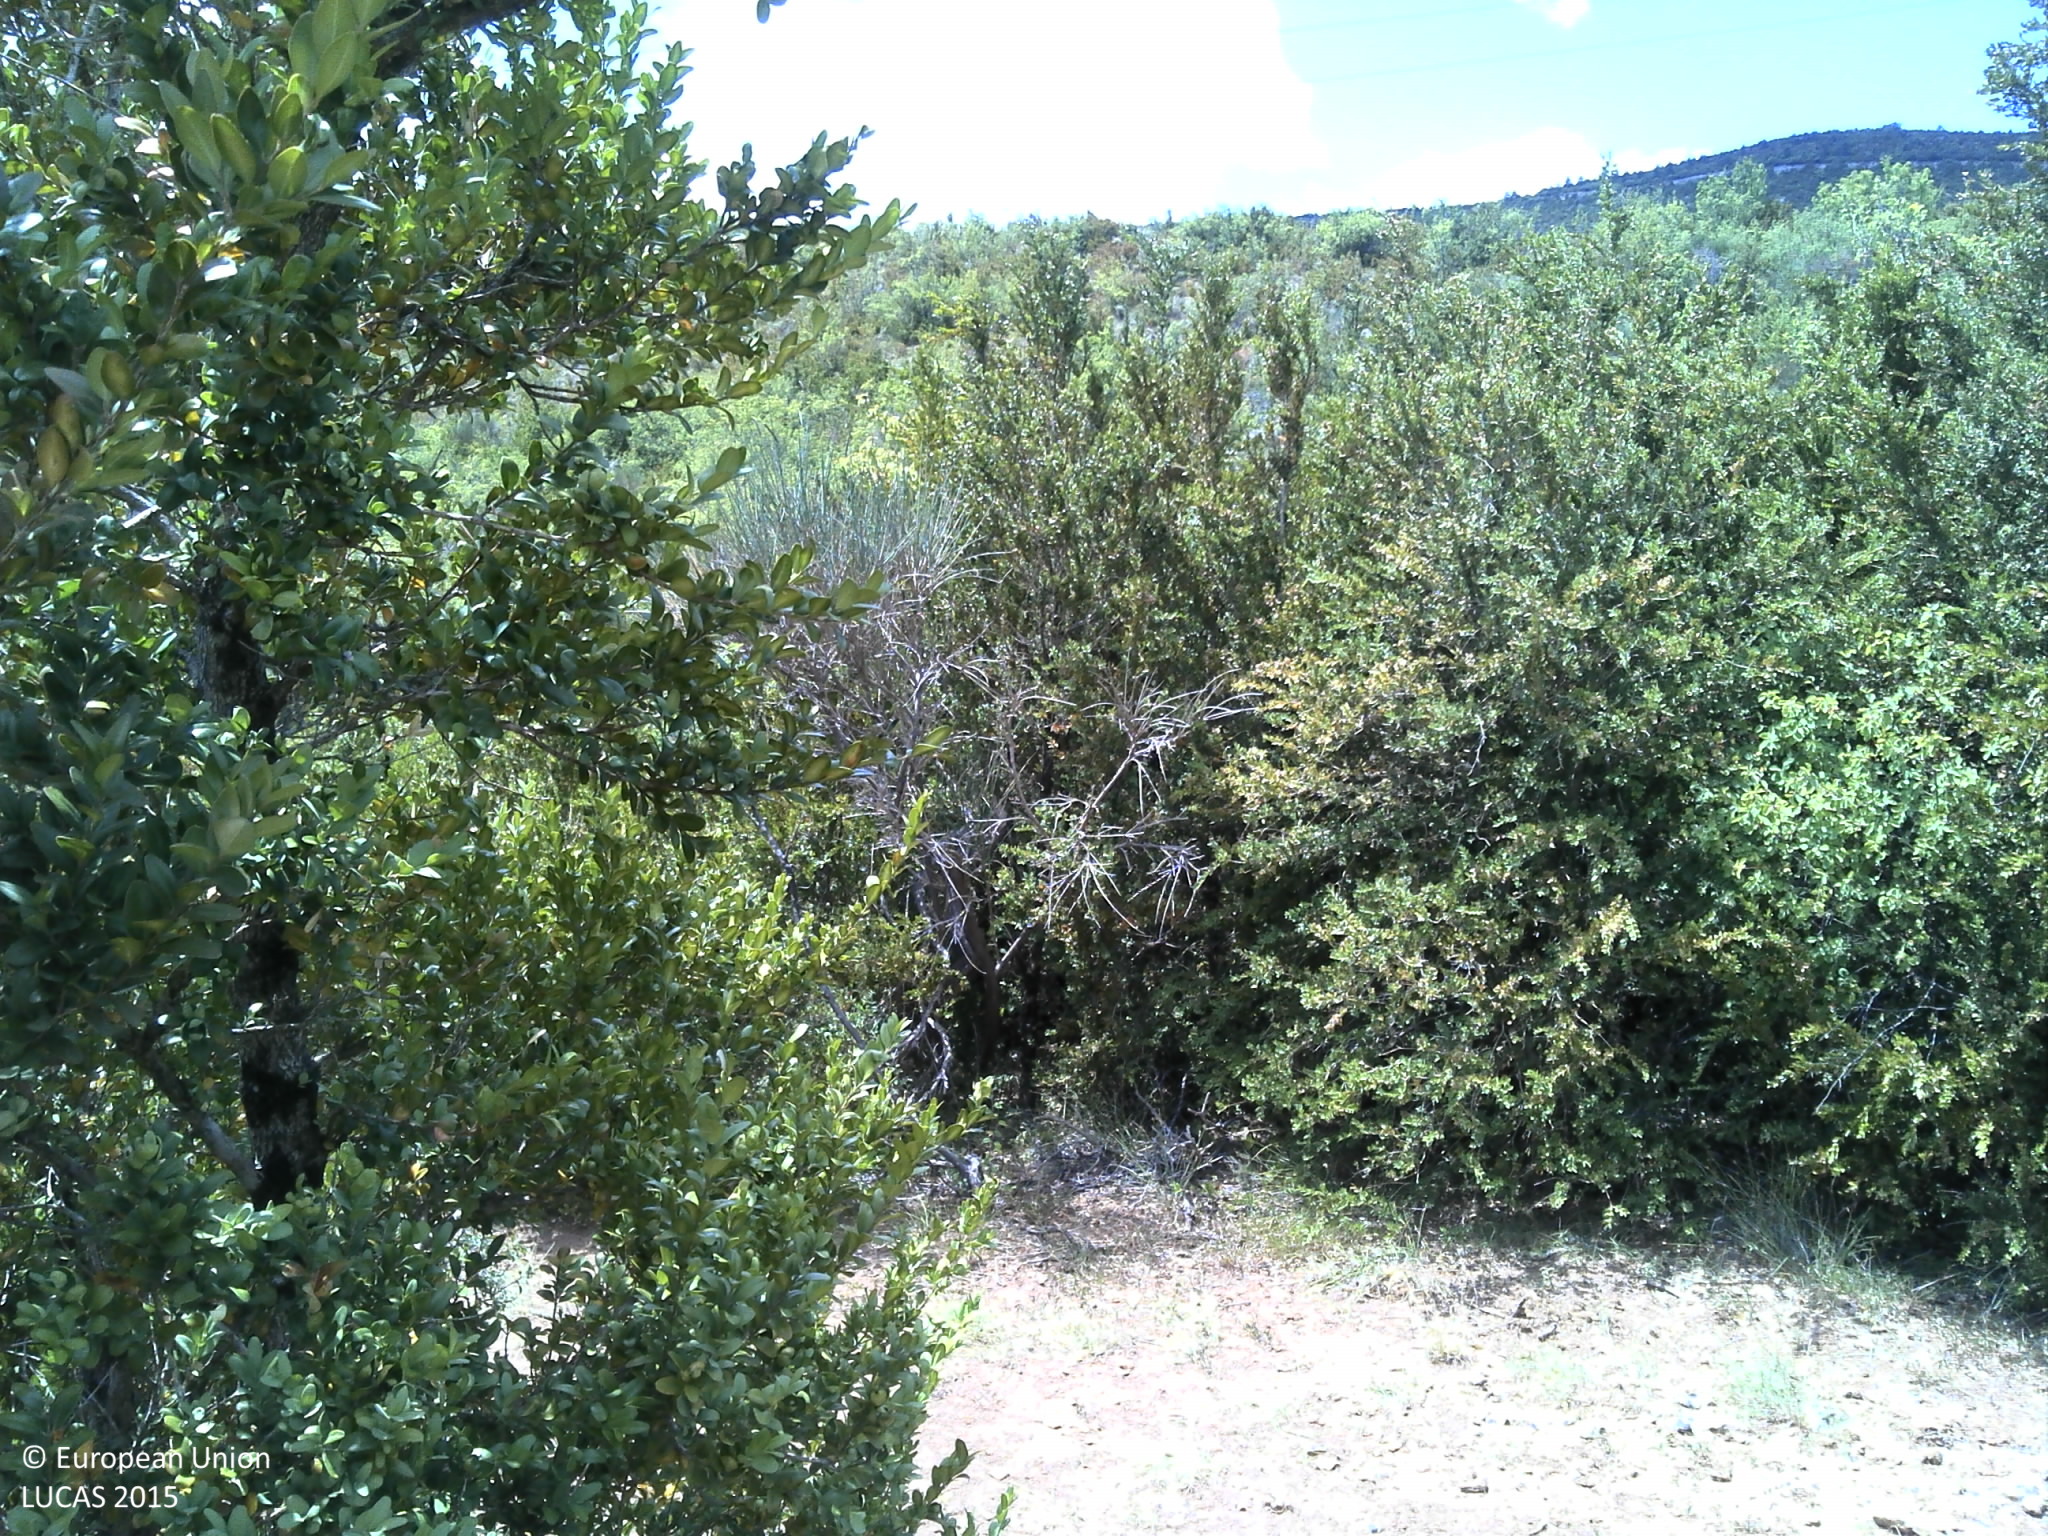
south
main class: Shrubland
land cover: Shrubland without tree cover
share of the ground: > 75 %
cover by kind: shrubs 80 %, herbaceous plants 10 %, consolidated bare surface 10 %
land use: Semi-natural and natural areas not in use
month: July
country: FR
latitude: 43.7467
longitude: 3.1900
